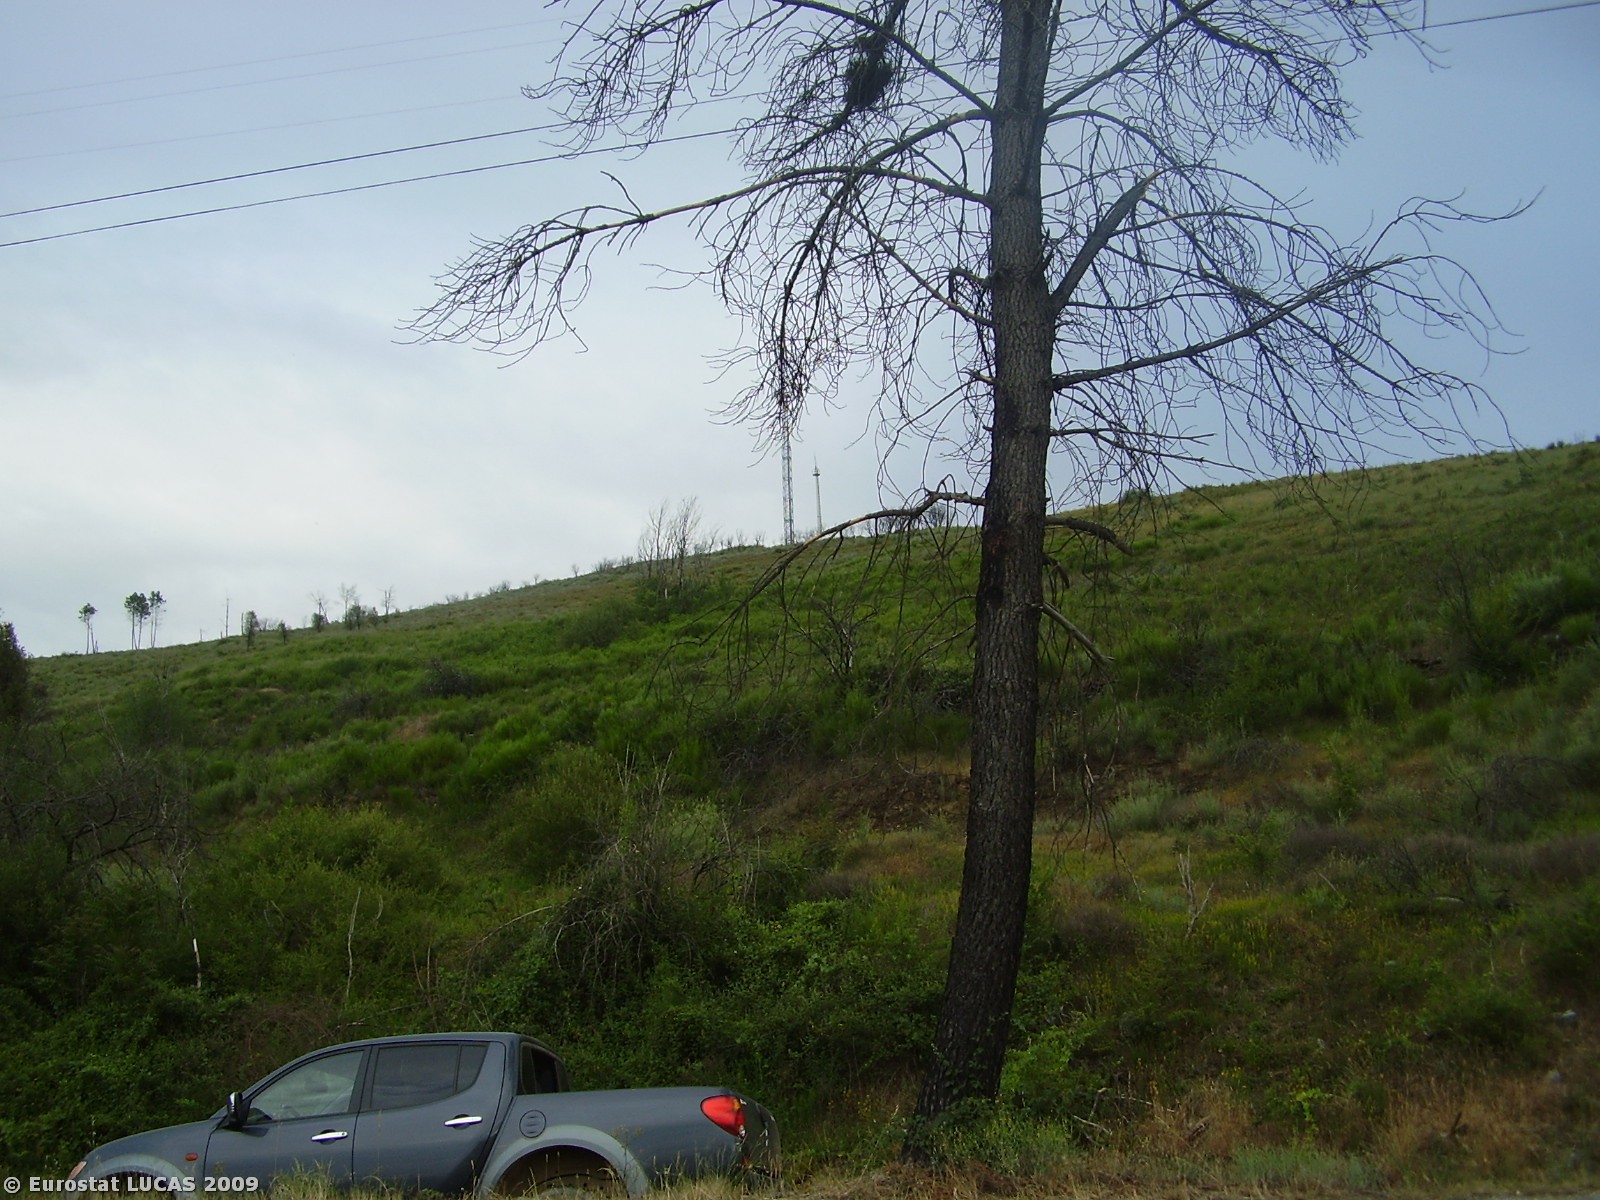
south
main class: Shrubland
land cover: Shrubland with sparse tree cover
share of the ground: > 75 %
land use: Nature reserves
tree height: > 5 m
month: June
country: PT
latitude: 41.7383
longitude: -6.5681
